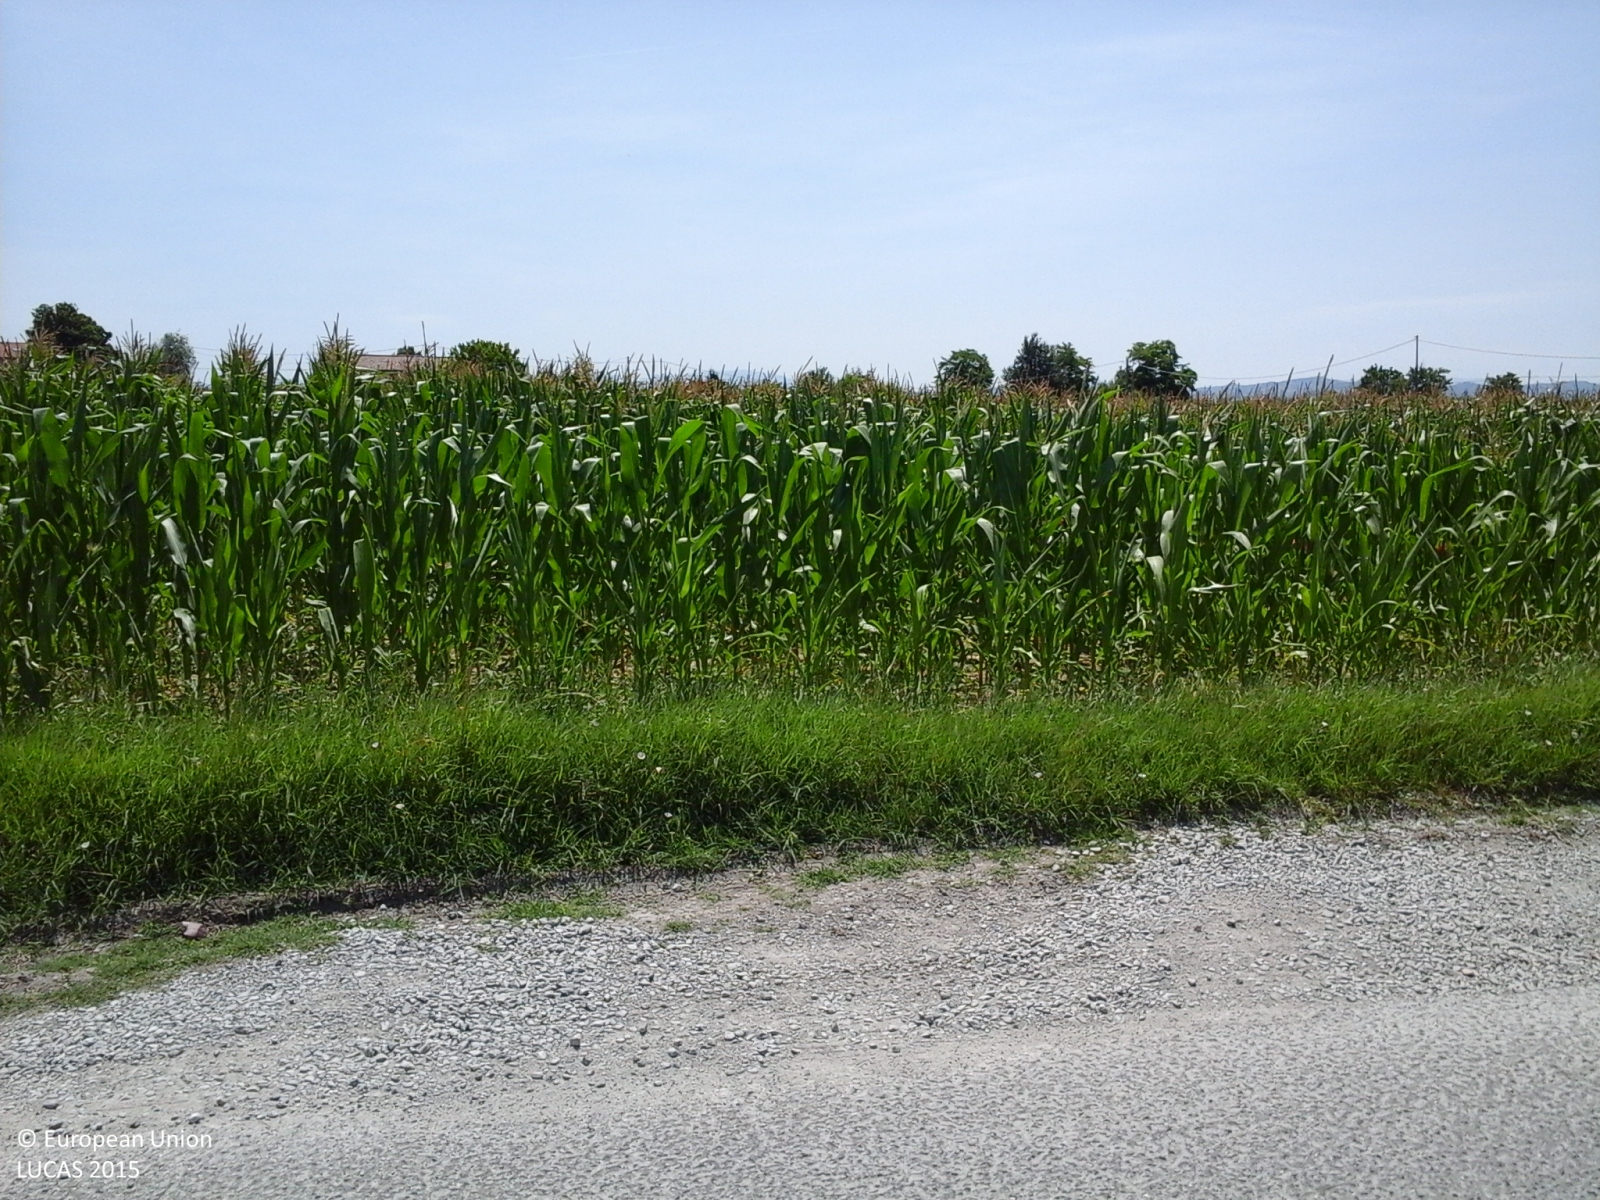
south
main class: Cropland
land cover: Lucerne
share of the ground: > 75 %
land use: Agriculture (excluding fallow land and kitchen gardens)
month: June
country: IT
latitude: 44.1614
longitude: 12.3581
